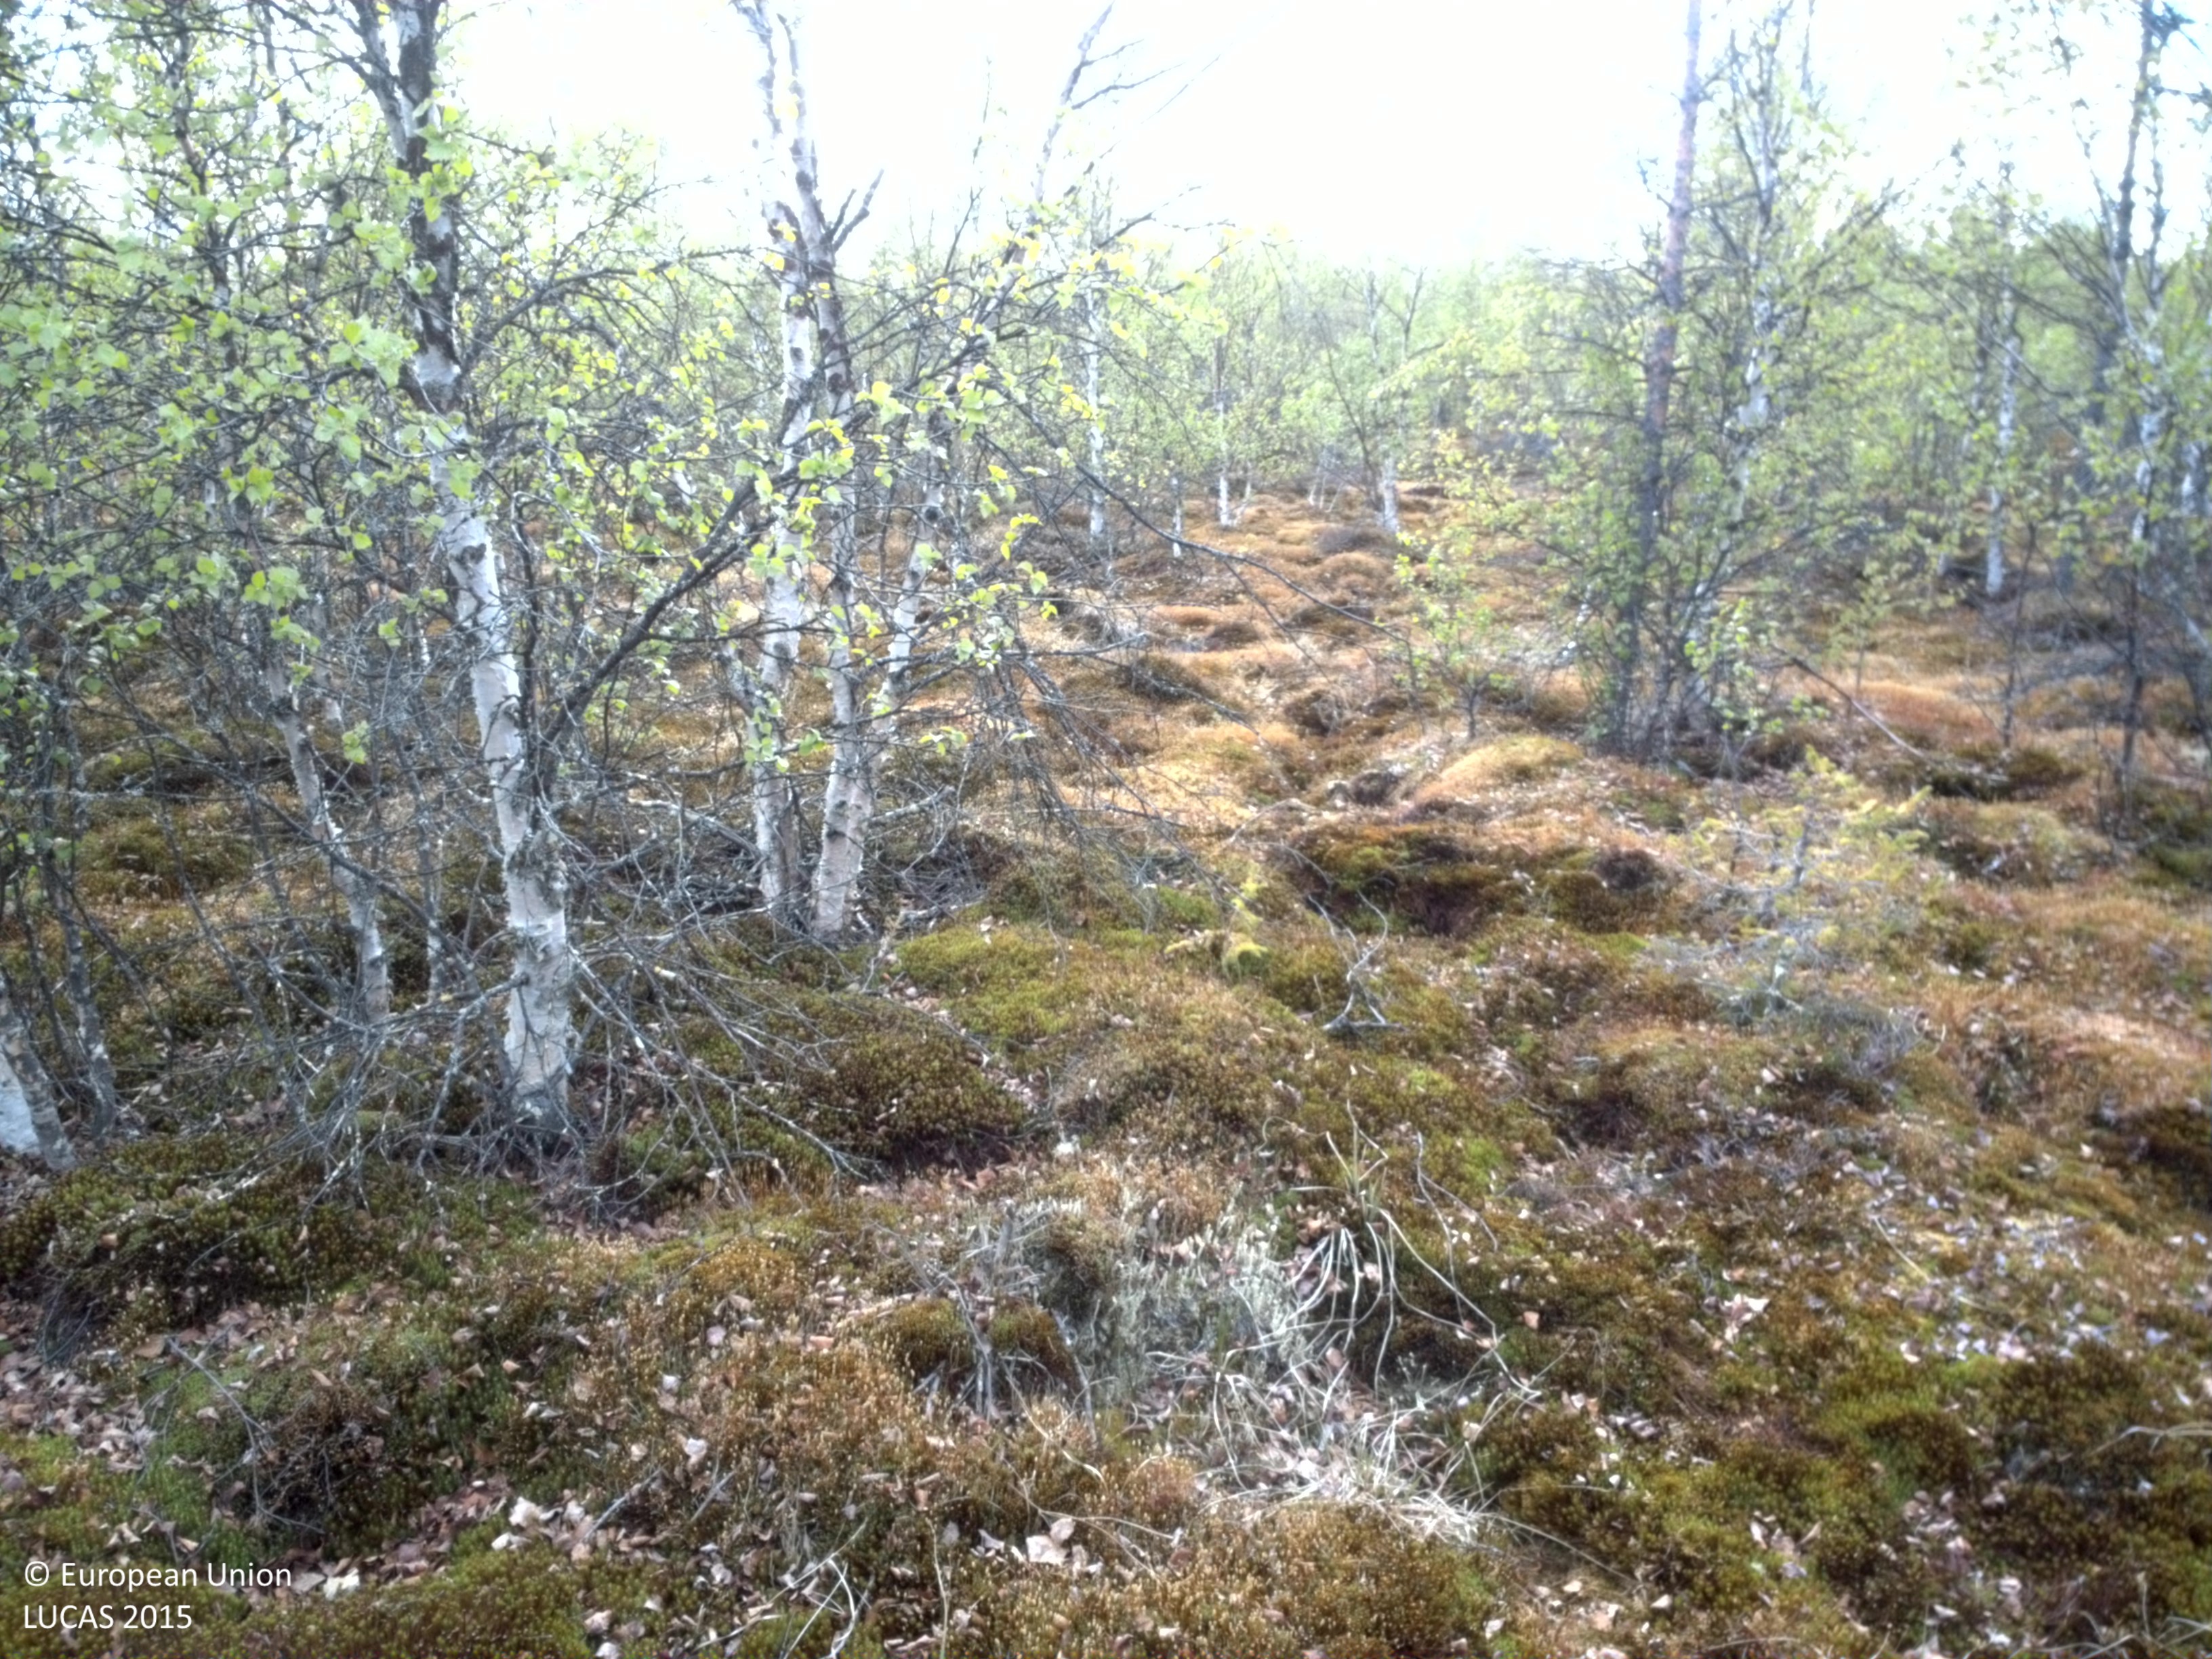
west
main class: Woodland
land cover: Broadleaved woodland
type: boreal forest
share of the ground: 25 - 50 %
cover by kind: lichens and mosses 60 %, broadleaved forest trees 40 %
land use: Forestry
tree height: < 5 m
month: June
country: SE
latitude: 66.9034
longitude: 21.5857
